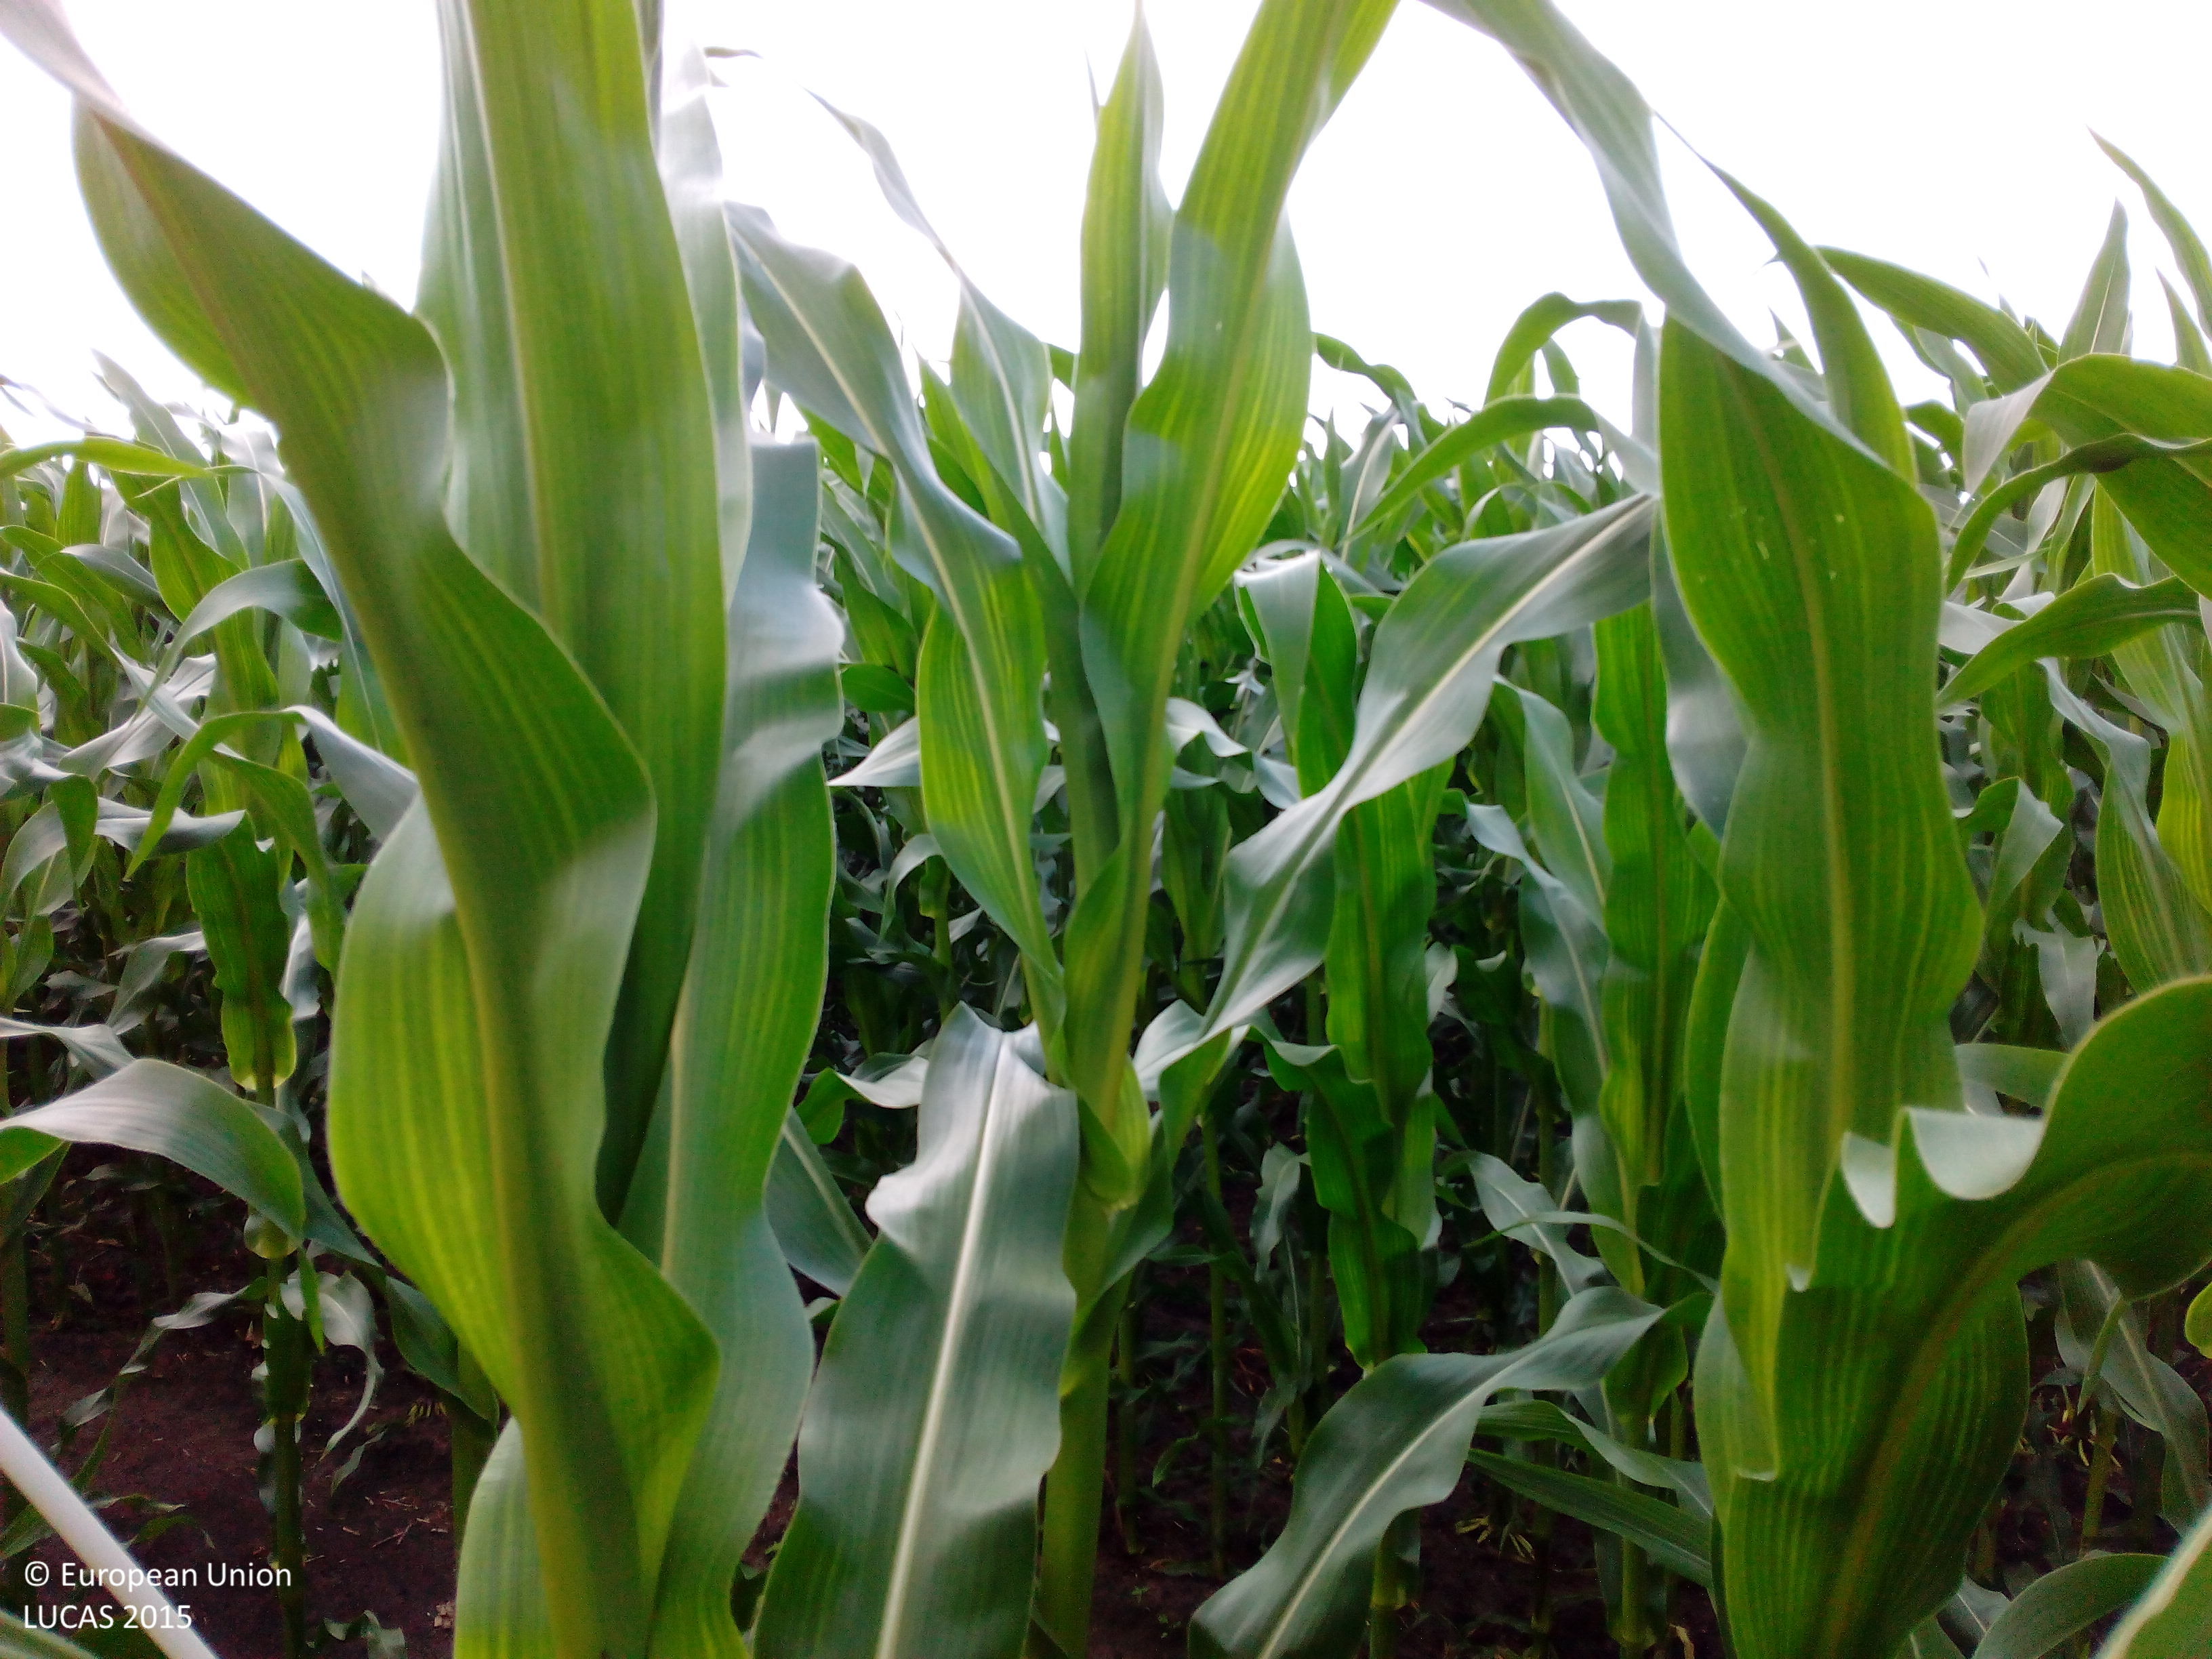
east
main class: Cropland
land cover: Maize
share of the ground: > 75 %
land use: Agriculture (excluding fallow land and kitchen gardens)
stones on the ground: < 10 %
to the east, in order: Maize; Abandoned hedges; Ditches and canals; Abandoned hedges; Maize; Abandoned hedges; Ditches and canals; Abandoned hedges; Maize
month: July
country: DE
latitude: 53.0257
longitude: 7.9878
